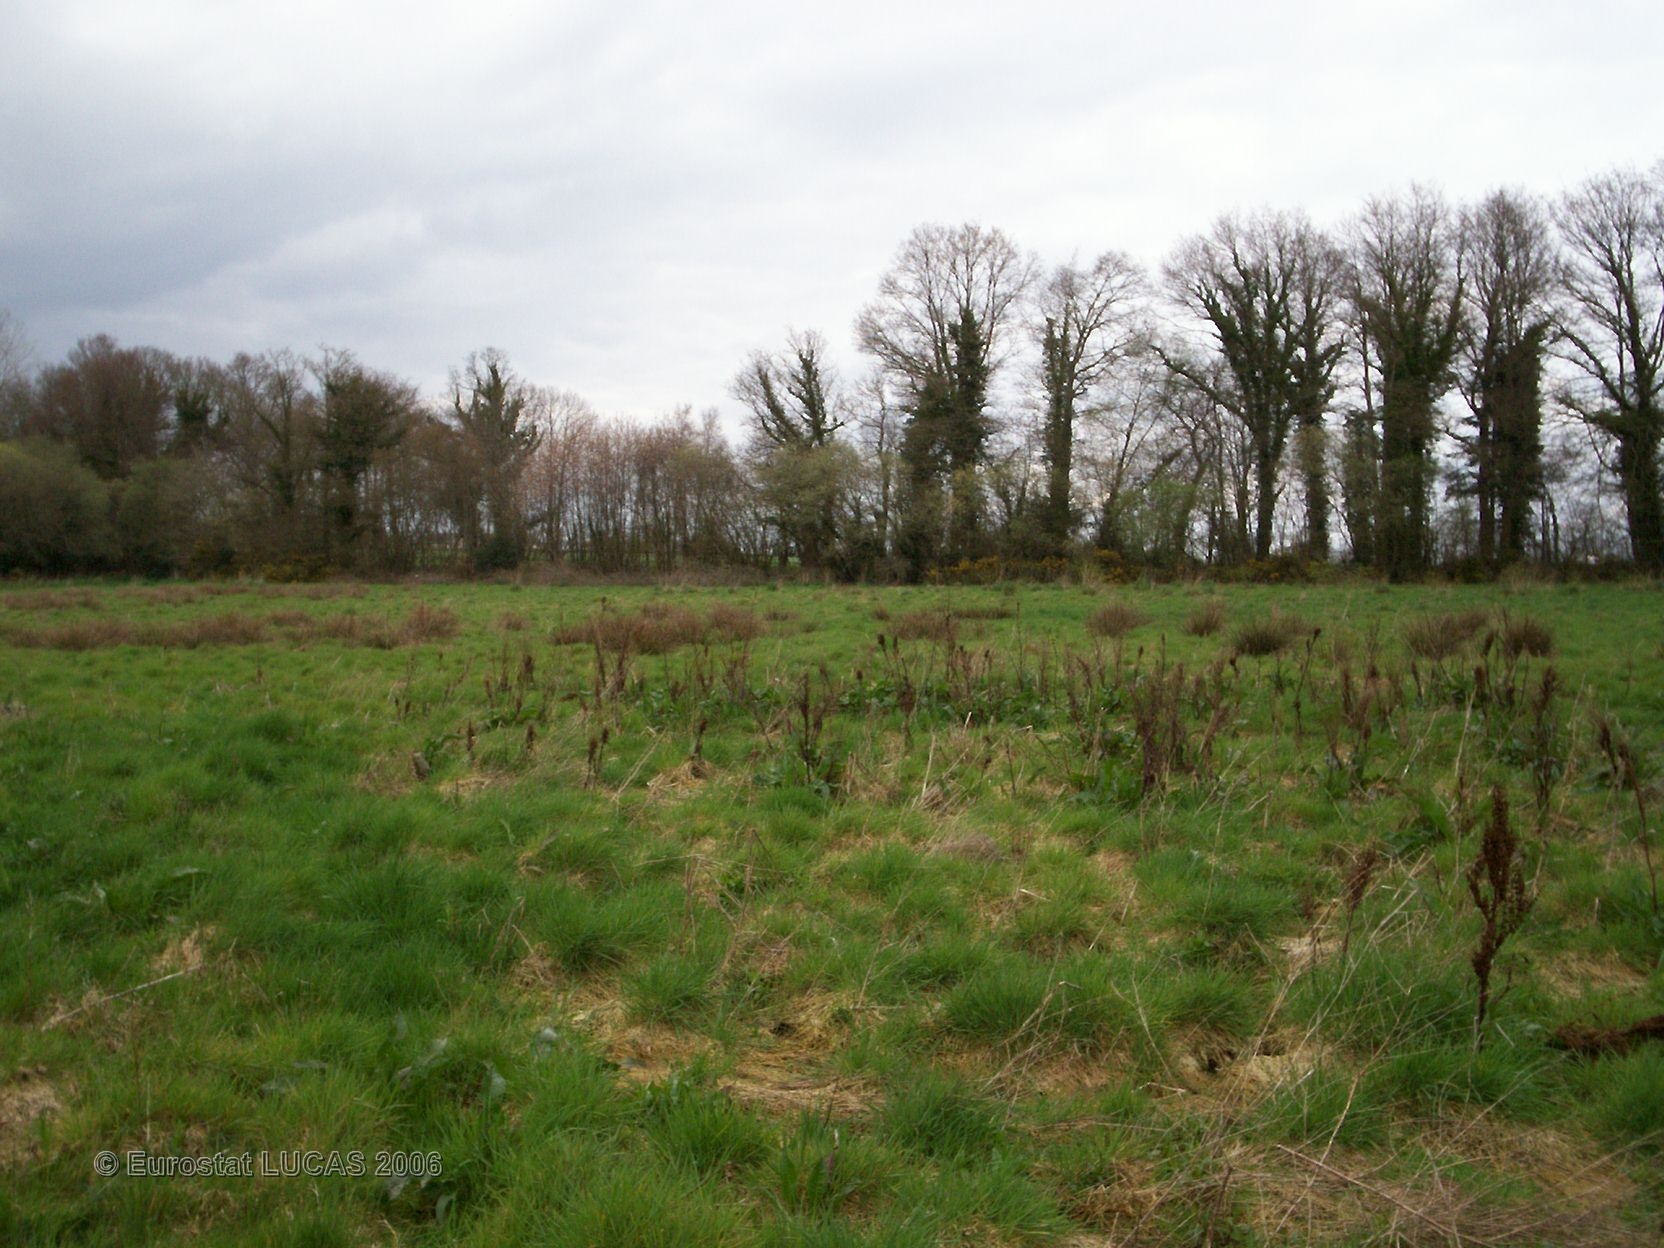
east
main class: Grassland
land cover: Grassland without tree/shrub cover
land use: Fallow land
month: April
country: FR
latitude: 48.1360
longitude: -2.8999
